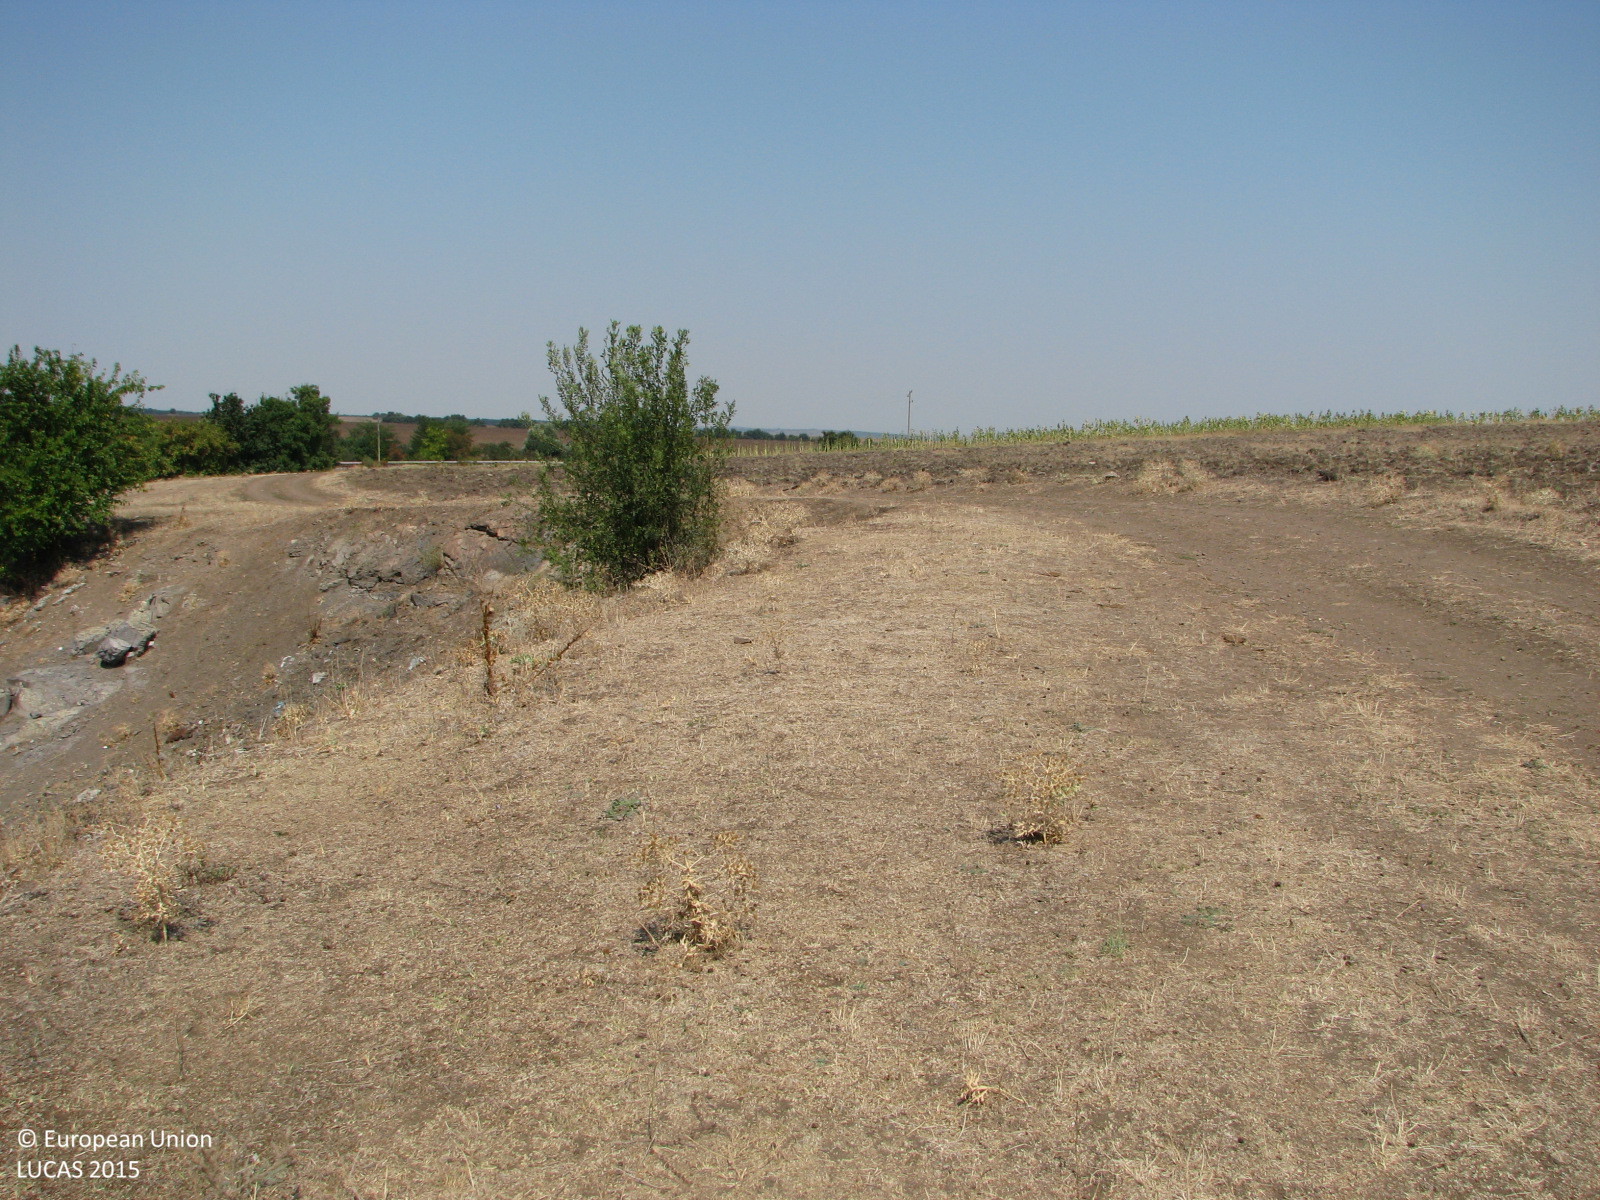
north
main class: Grassland
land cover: Grassland without tree/shrub cover
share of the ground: > 75 %
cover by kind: herbaceous plants 90 %, unconsolidated bare surface 10 %
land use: Agriculture (excluding fallow land and kitchen gardens)
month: September
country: BG
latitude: 42.3805
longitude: 26.7979
